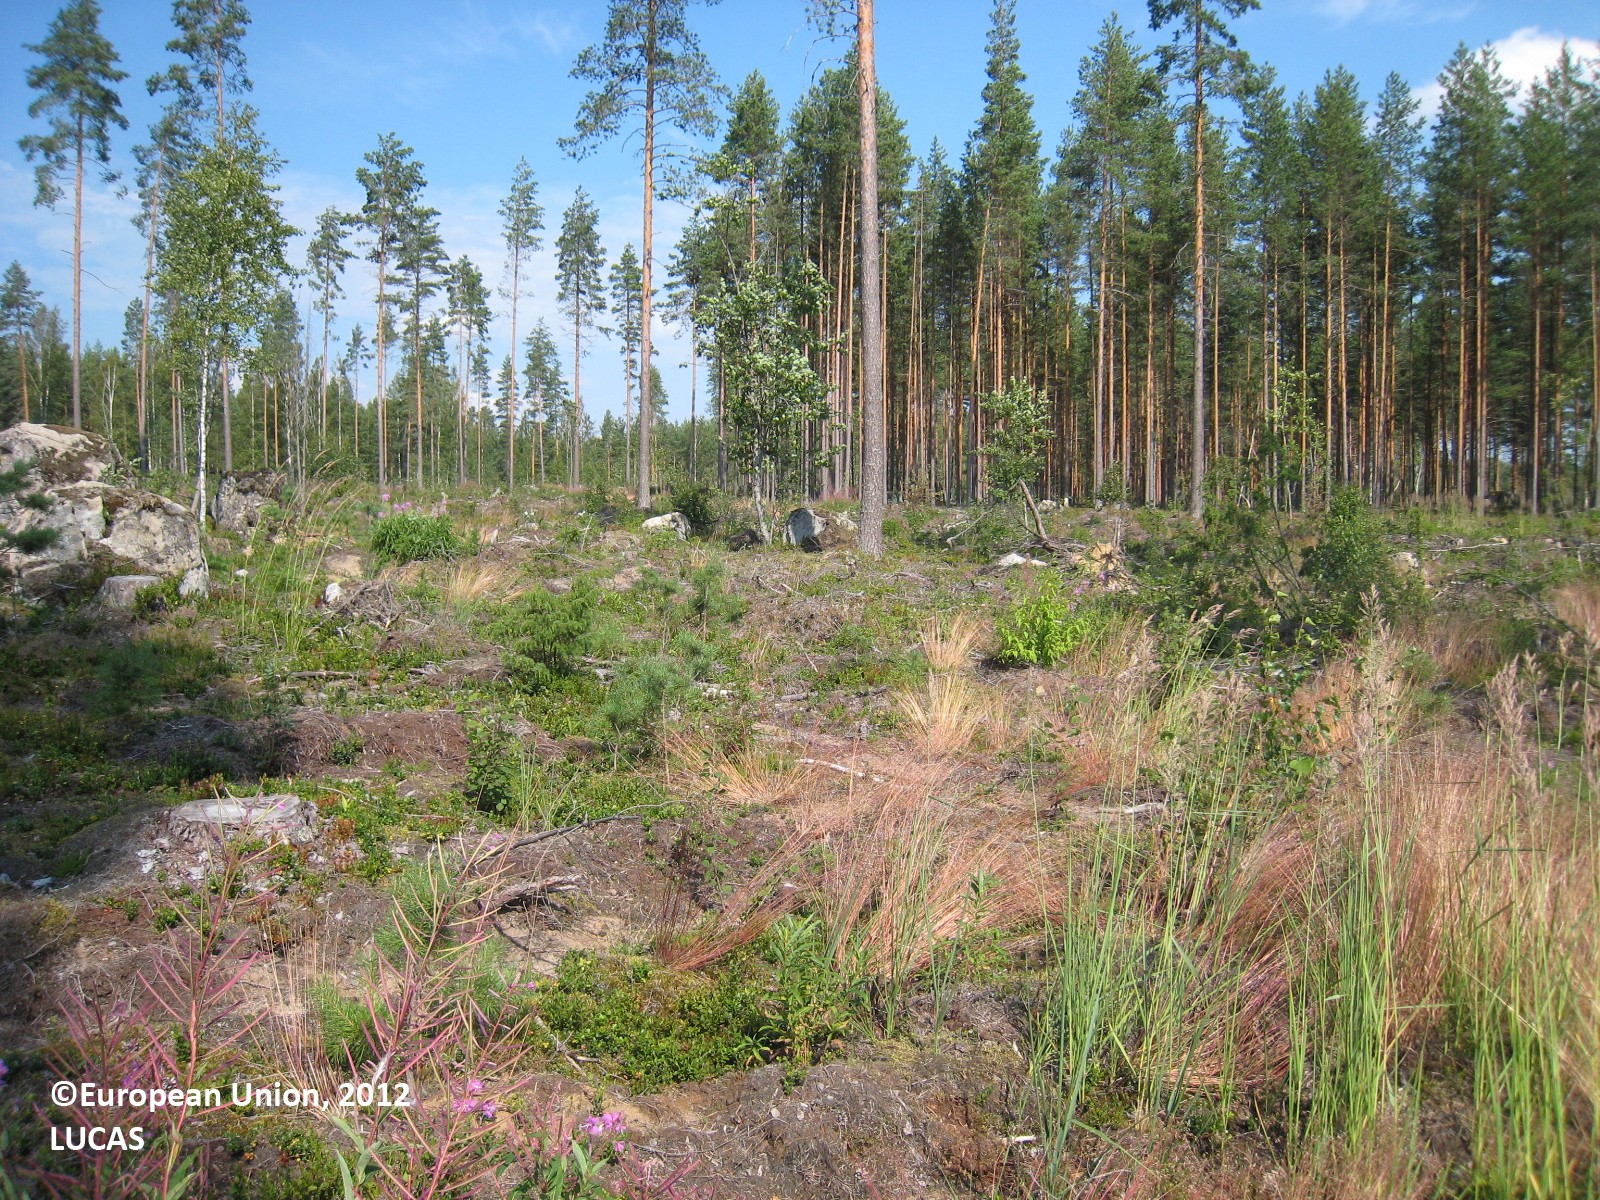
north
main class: Shrubland
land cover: Shrubland with sparse tree cover
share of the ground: > 75 %
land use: Forestry
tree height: > 5 m
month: July
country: FI
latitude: 61.7511
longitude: 26.1391
